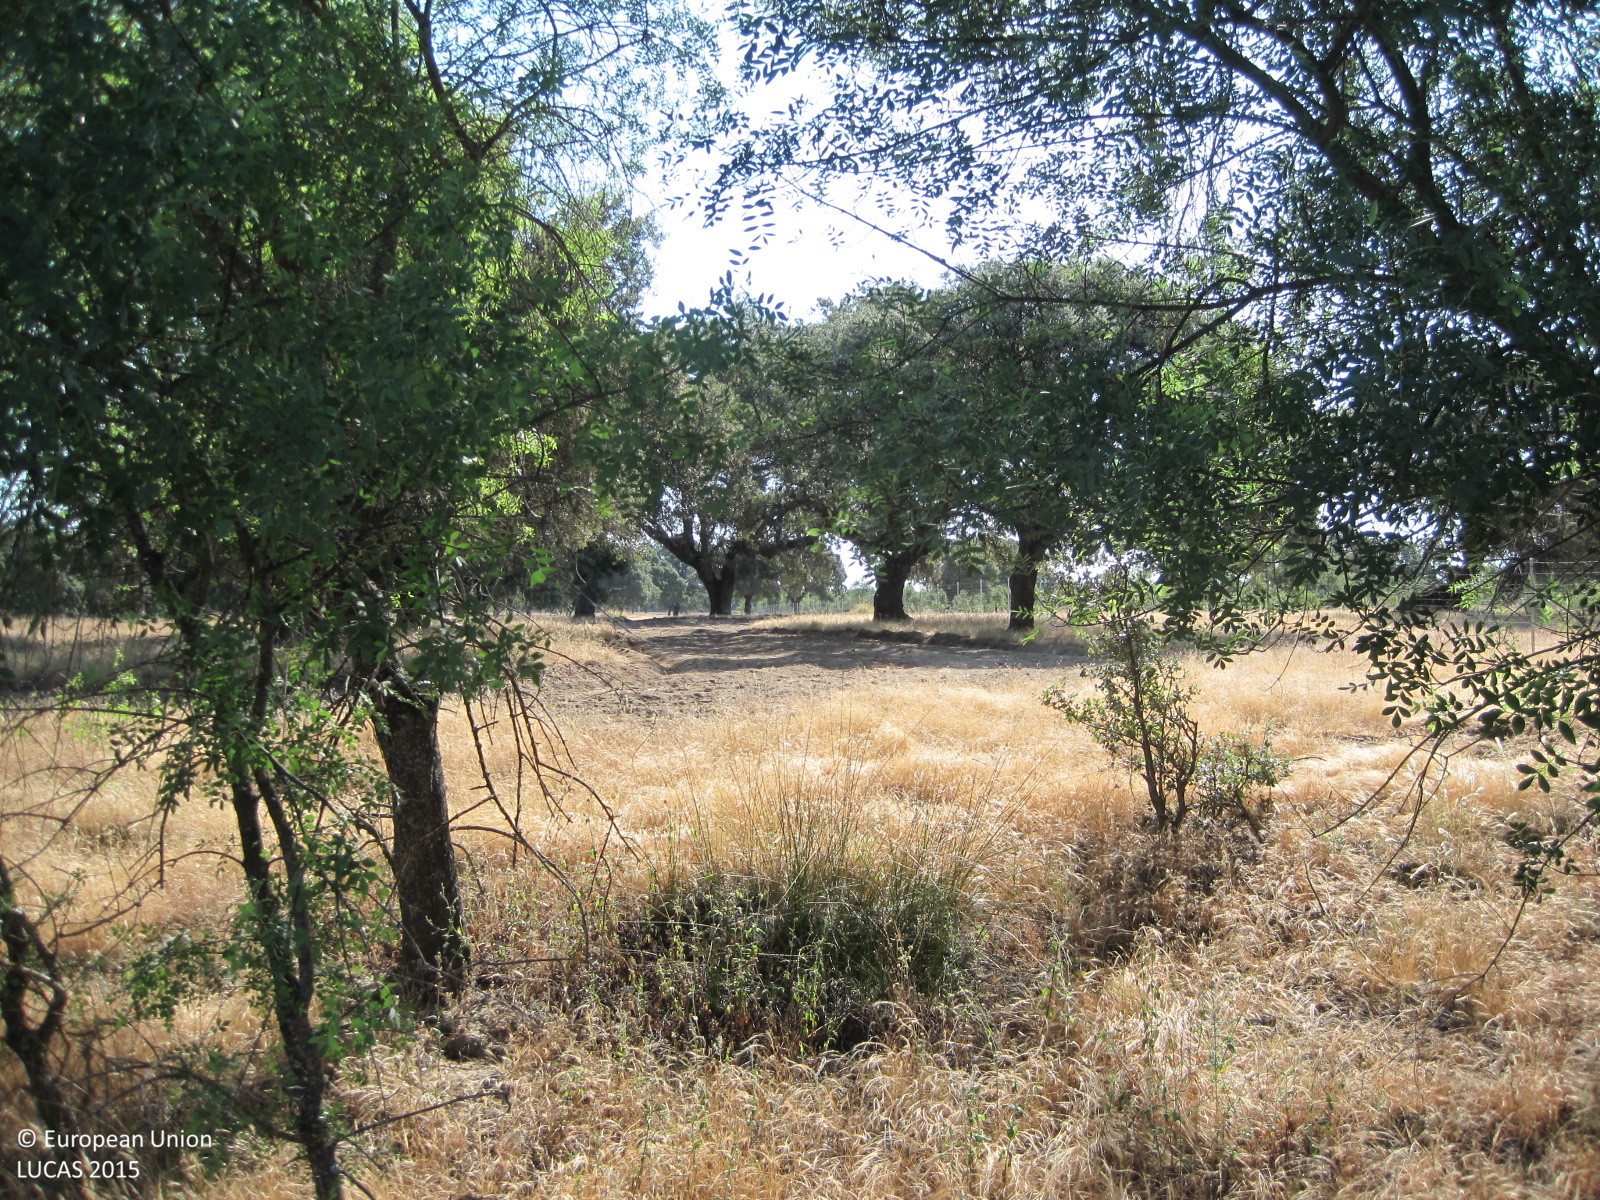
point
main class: Woodland
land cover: Broadleaved woodland
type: broadleaved evergreen forest
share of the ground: 25 - 50 %
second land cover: Grassland without tree/shrub cover
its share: 50 - 75 %
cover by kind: herbaceous plants 55 %, broadleaved forest trees 45 %
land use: Forestry
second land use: Agriculture (excluding fallow land and kitchen gardens)
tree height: > 5 m
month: June
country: ES
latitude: 40.0441
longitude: -4.9957
